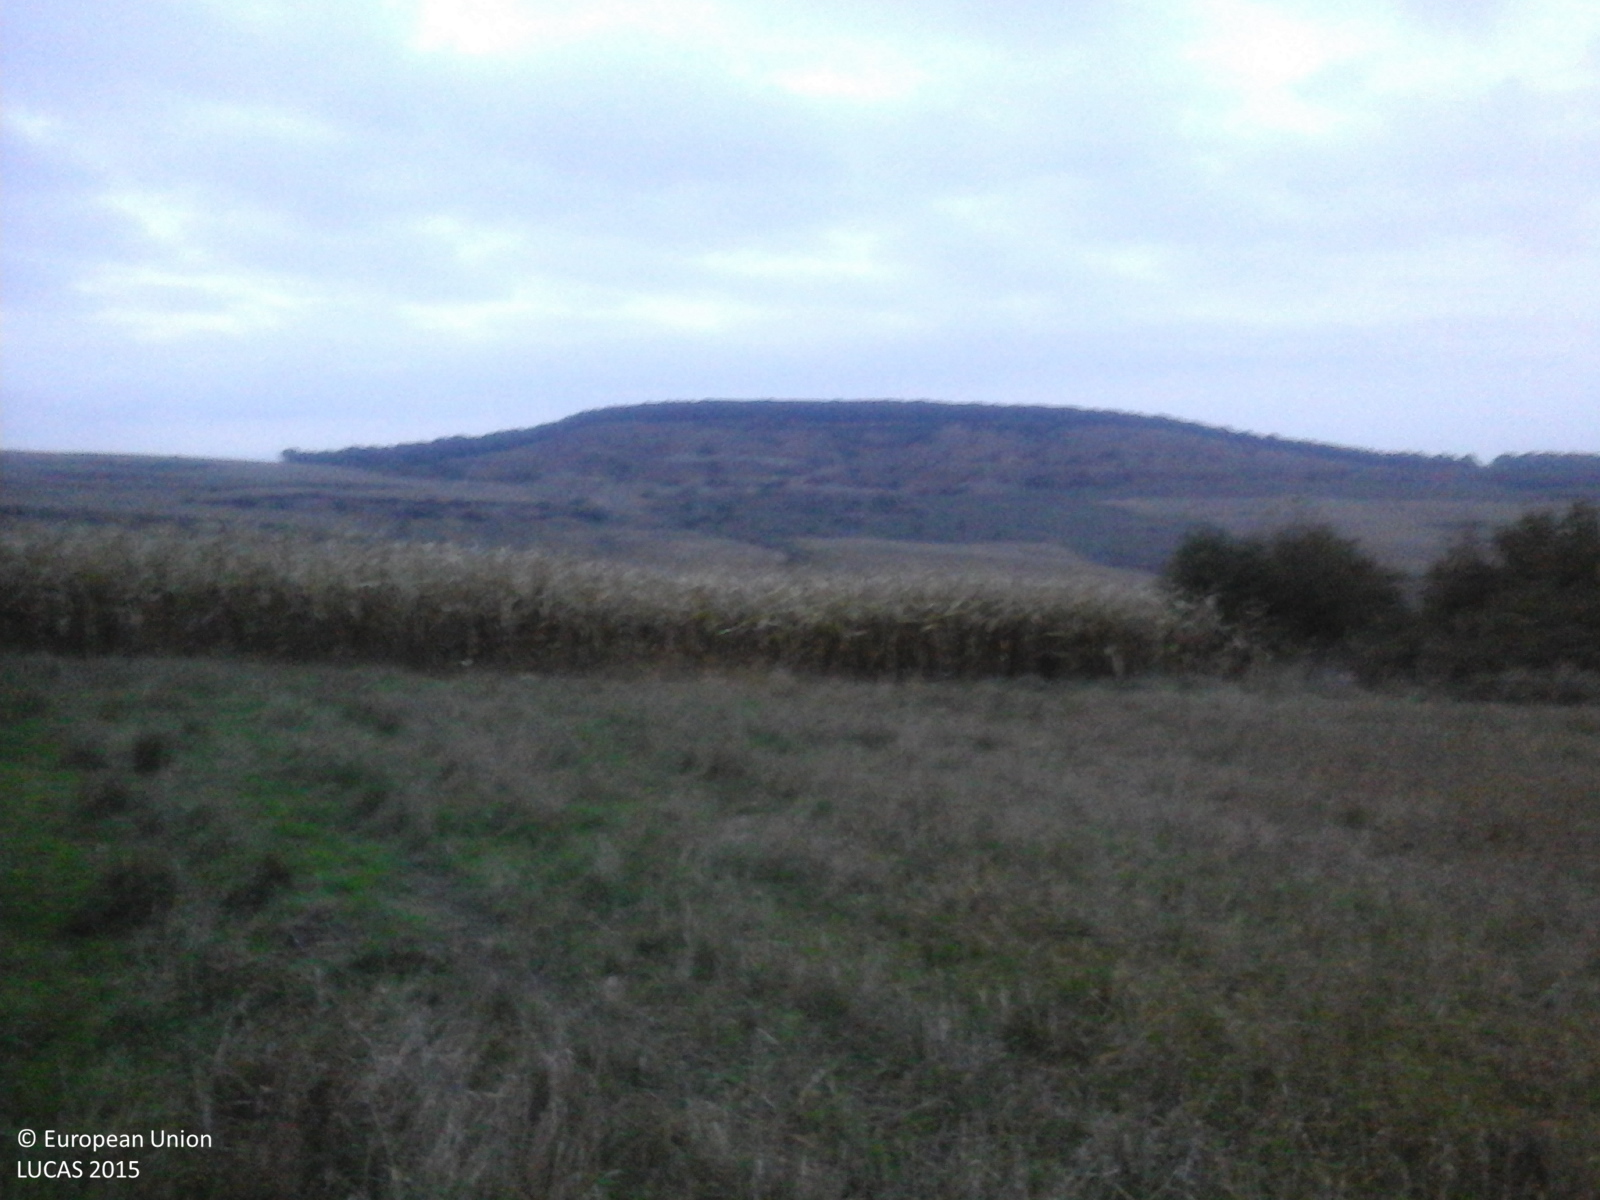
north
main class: Grassland
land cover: Grassland without tree/shrub cover
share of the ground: > 75 %
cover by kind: herbaceous plants 100 %
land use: Agriculture (excluding fallow land and kitchen gardens)
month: October
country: RO
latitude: 46.3212
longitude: 23.8529
